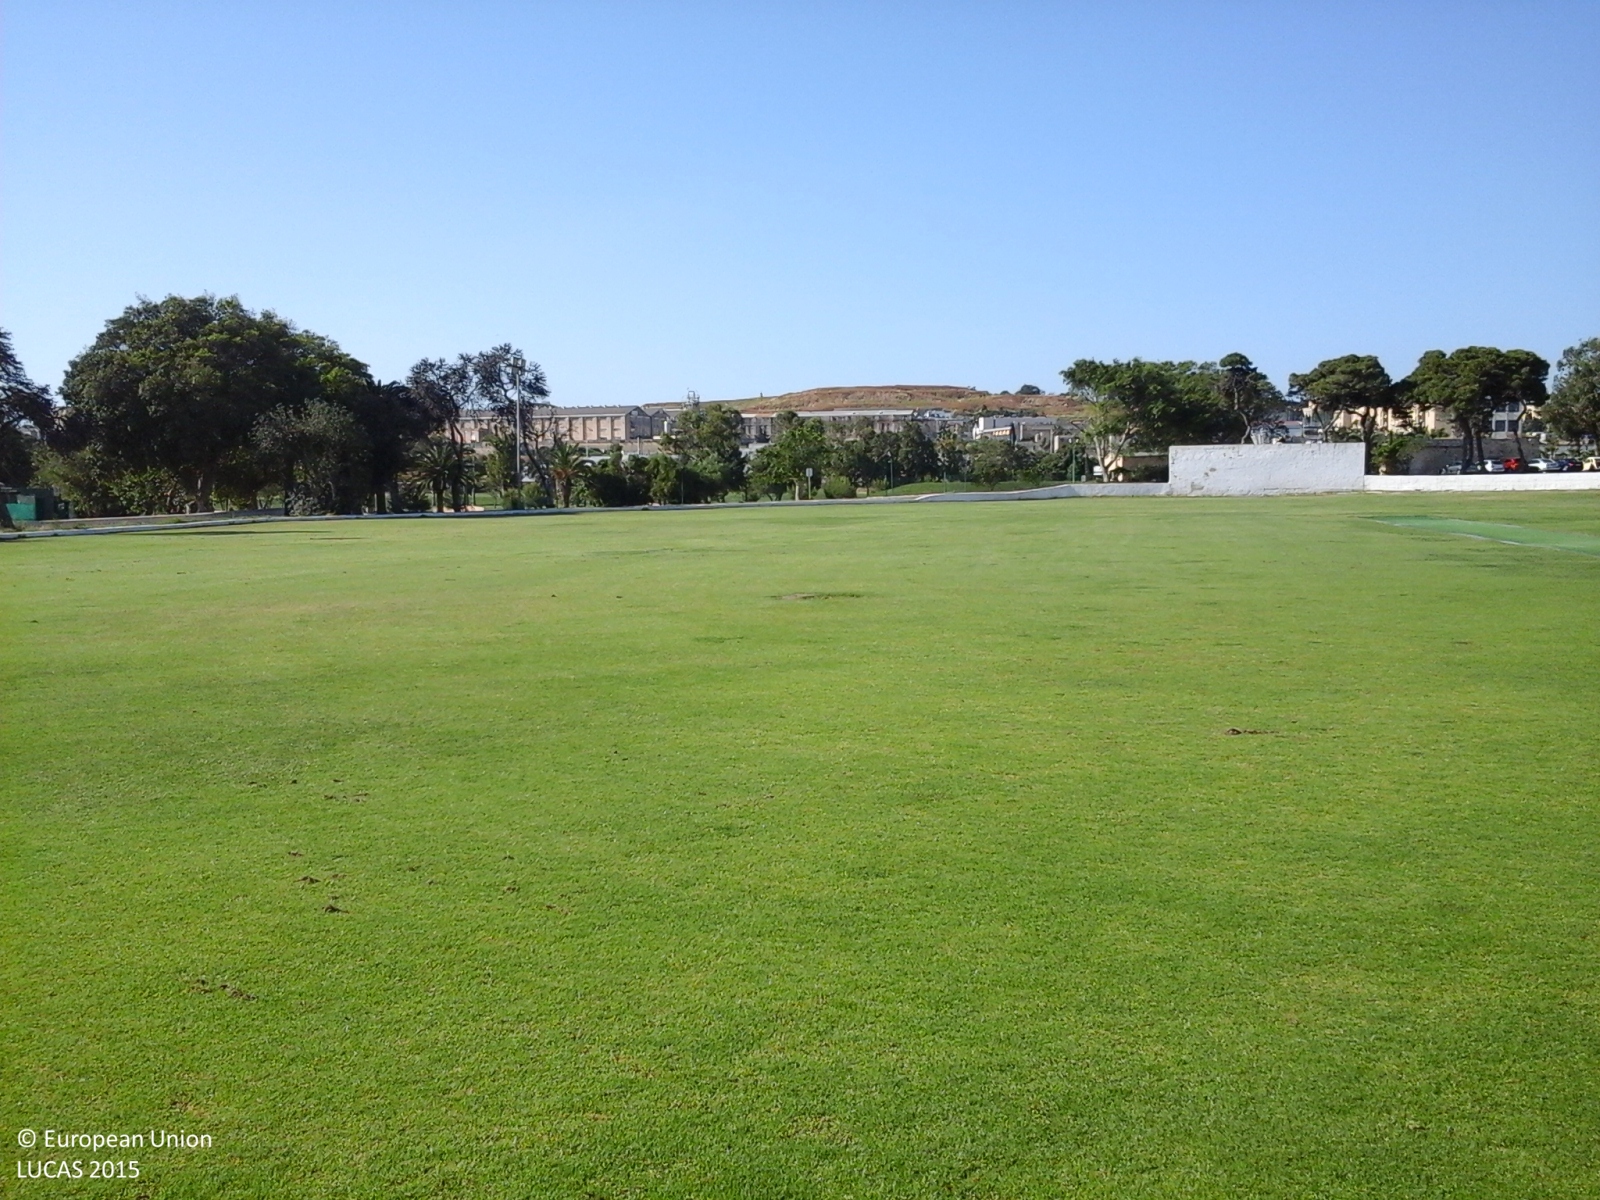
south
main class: Grassland
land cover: Grassland without tree/shrub cover
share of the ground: > 75 %
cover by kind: herbaceous plants 100 %
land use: Sport
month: May
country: MT
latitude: 35.8763
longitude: 14.4886
